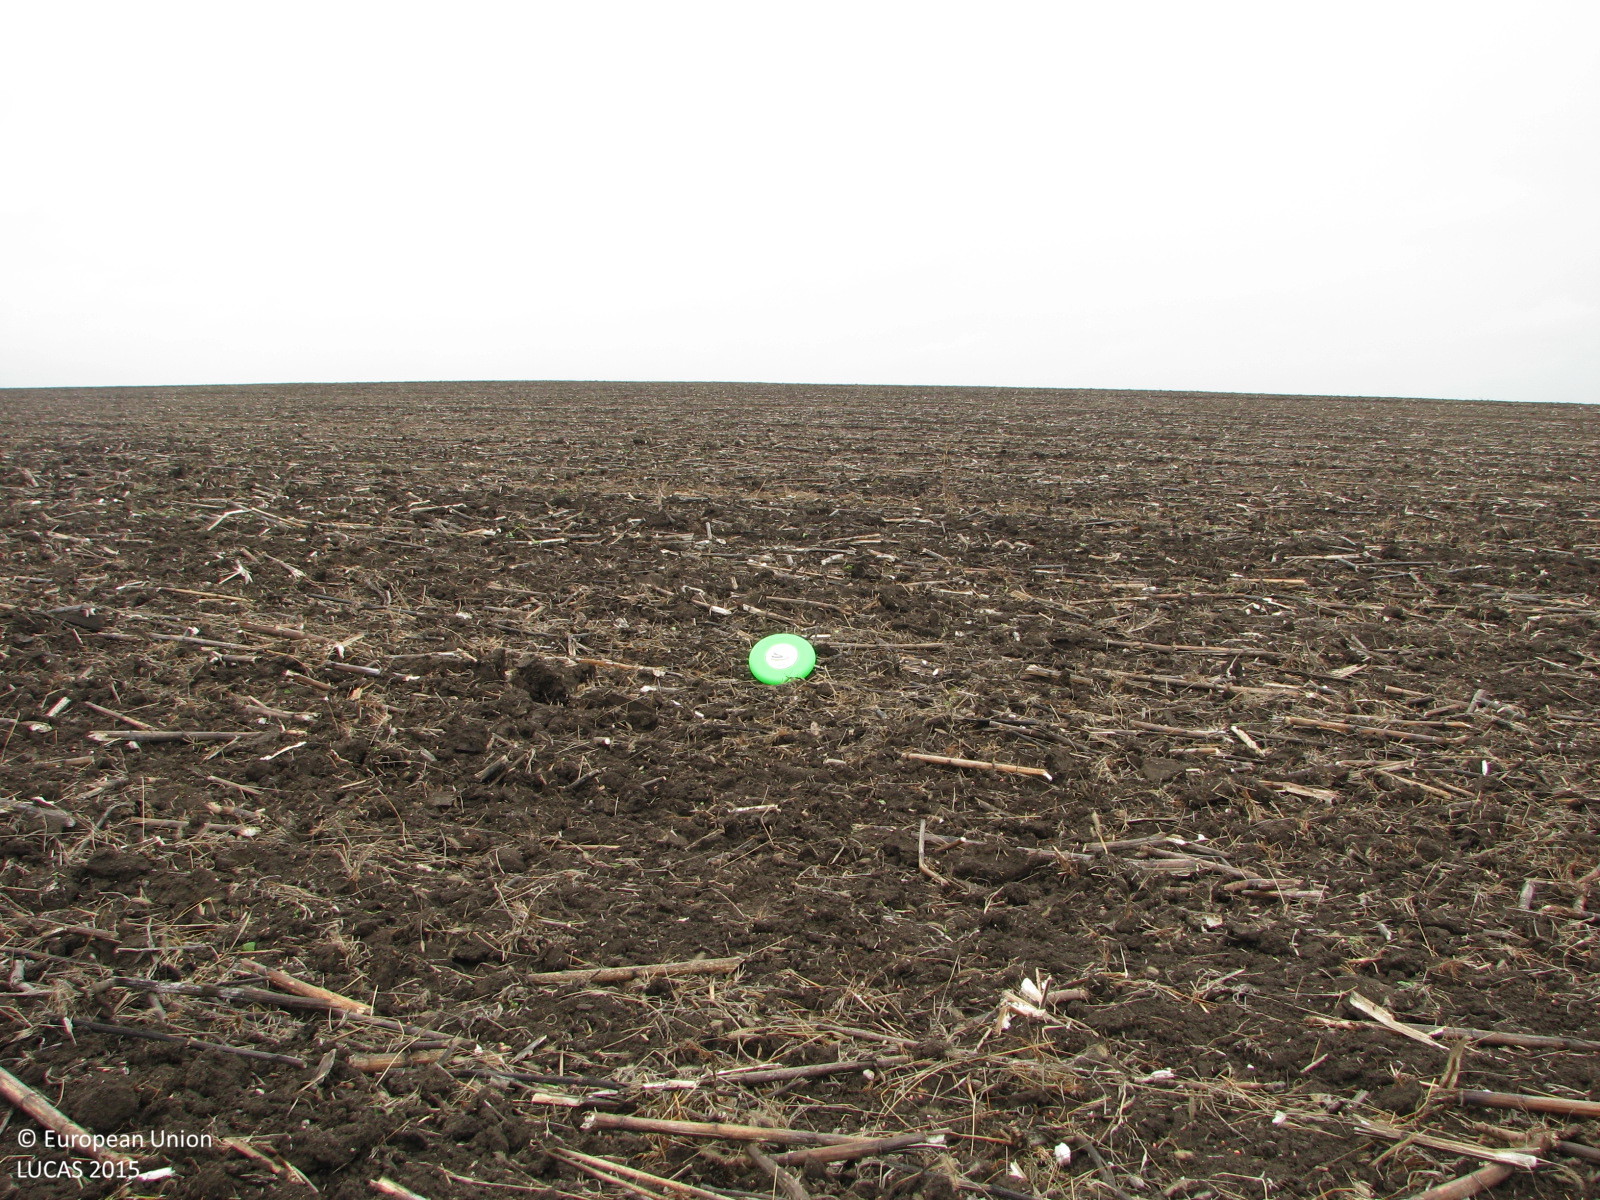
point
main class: Cropland
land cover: Sunflower
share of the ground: < 10 %
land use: Agriculture (excluding fallow land and kitchen gardens)
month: October
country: BG
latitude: 42.4163
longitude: 26.5839
